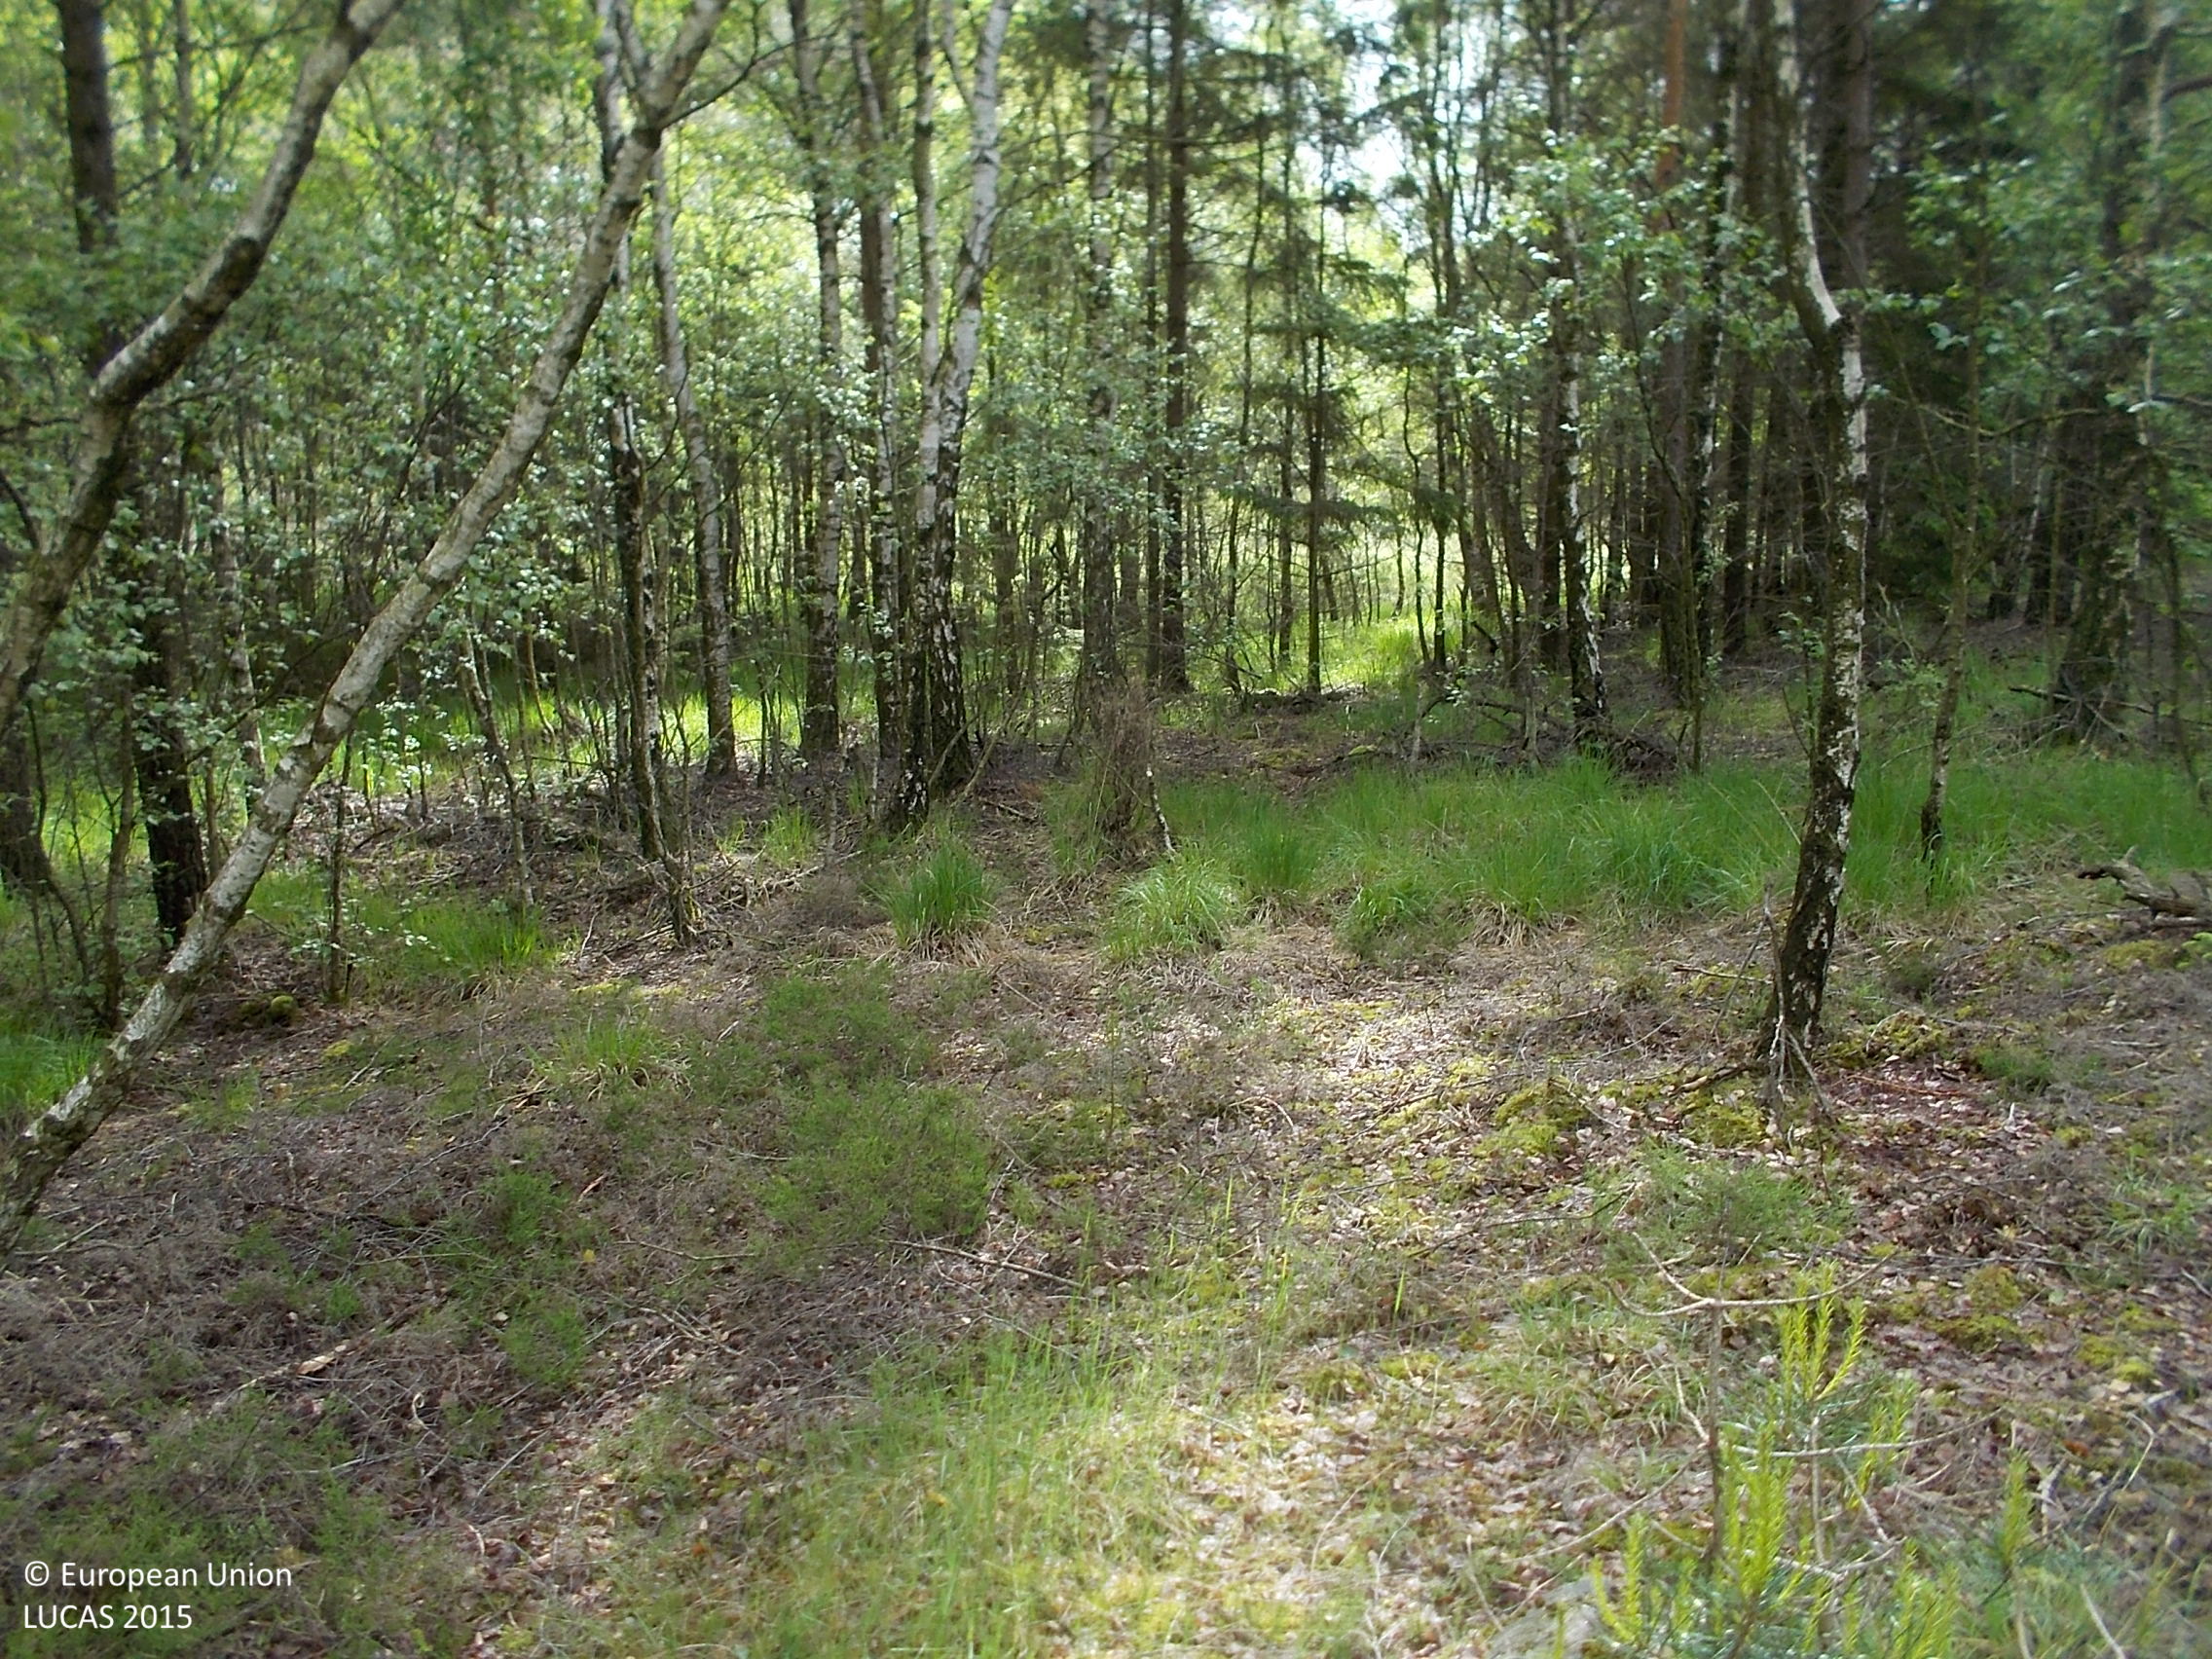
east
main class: Woodland
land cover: Broadleaved woodland
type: hemiboreal forest and nemoral coniferous forest and mixed broadleaved-coniferous forest
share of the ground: 10 - 25 %
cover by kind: herbaceous plants 40 %, lichens and mosses 30 %, broadleaved forest trees 10 %, shrubs 10 %, consolidated bare surface 10 %
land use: Forestry
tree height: > 5 m
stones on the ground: < 10 %
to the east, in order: Broadleaved woodland; Shrubland with sparse tree cover; Electric lines; Shrubland with sparse tree cover; Broadleaved woodland; Pine dominated mixed woodland; Broadleaved woodland
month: June
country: SE
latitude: 57.3743
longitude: 12.1753
